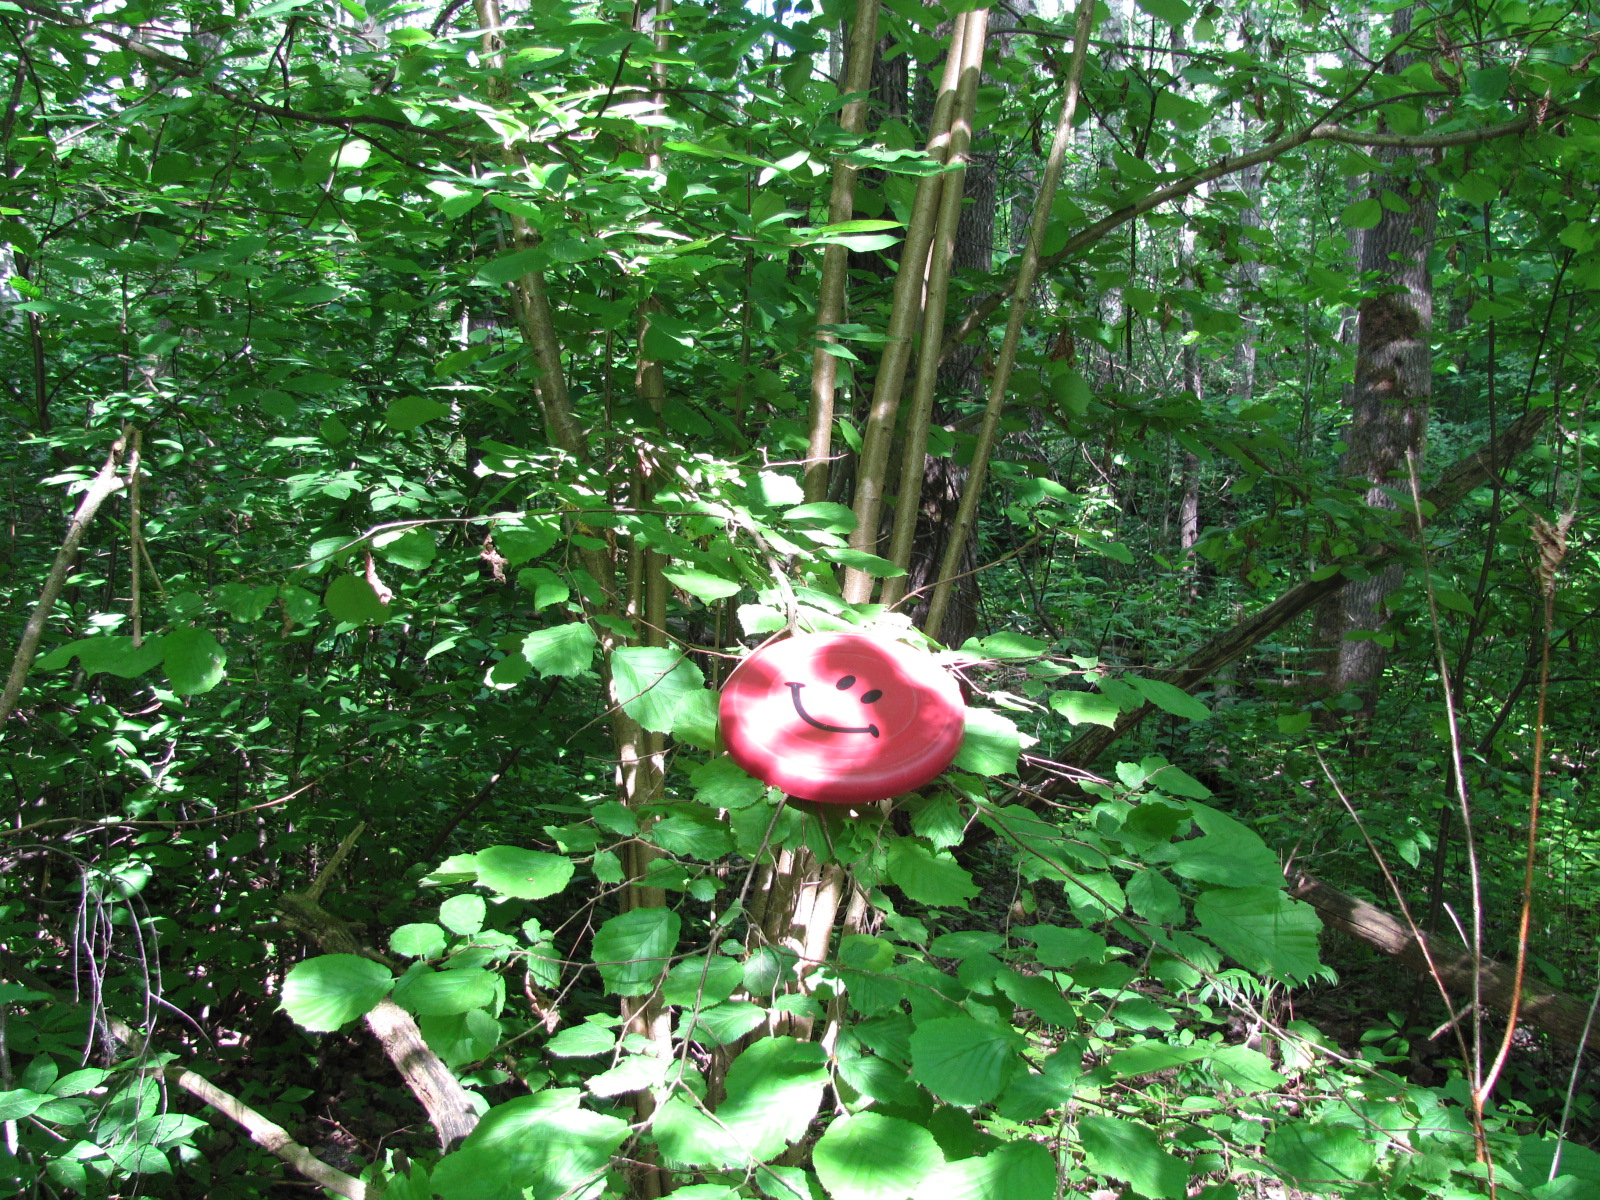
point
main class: Woodland
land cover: Broadleaved woodland
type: non-riverine alder, birch or aspen forest
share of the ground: > 75 %
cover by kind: broadleaved forest trees 100 %
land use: Forestry
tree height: > 5 m
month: June
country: LV
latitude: 56.8725
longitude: 24.3818
